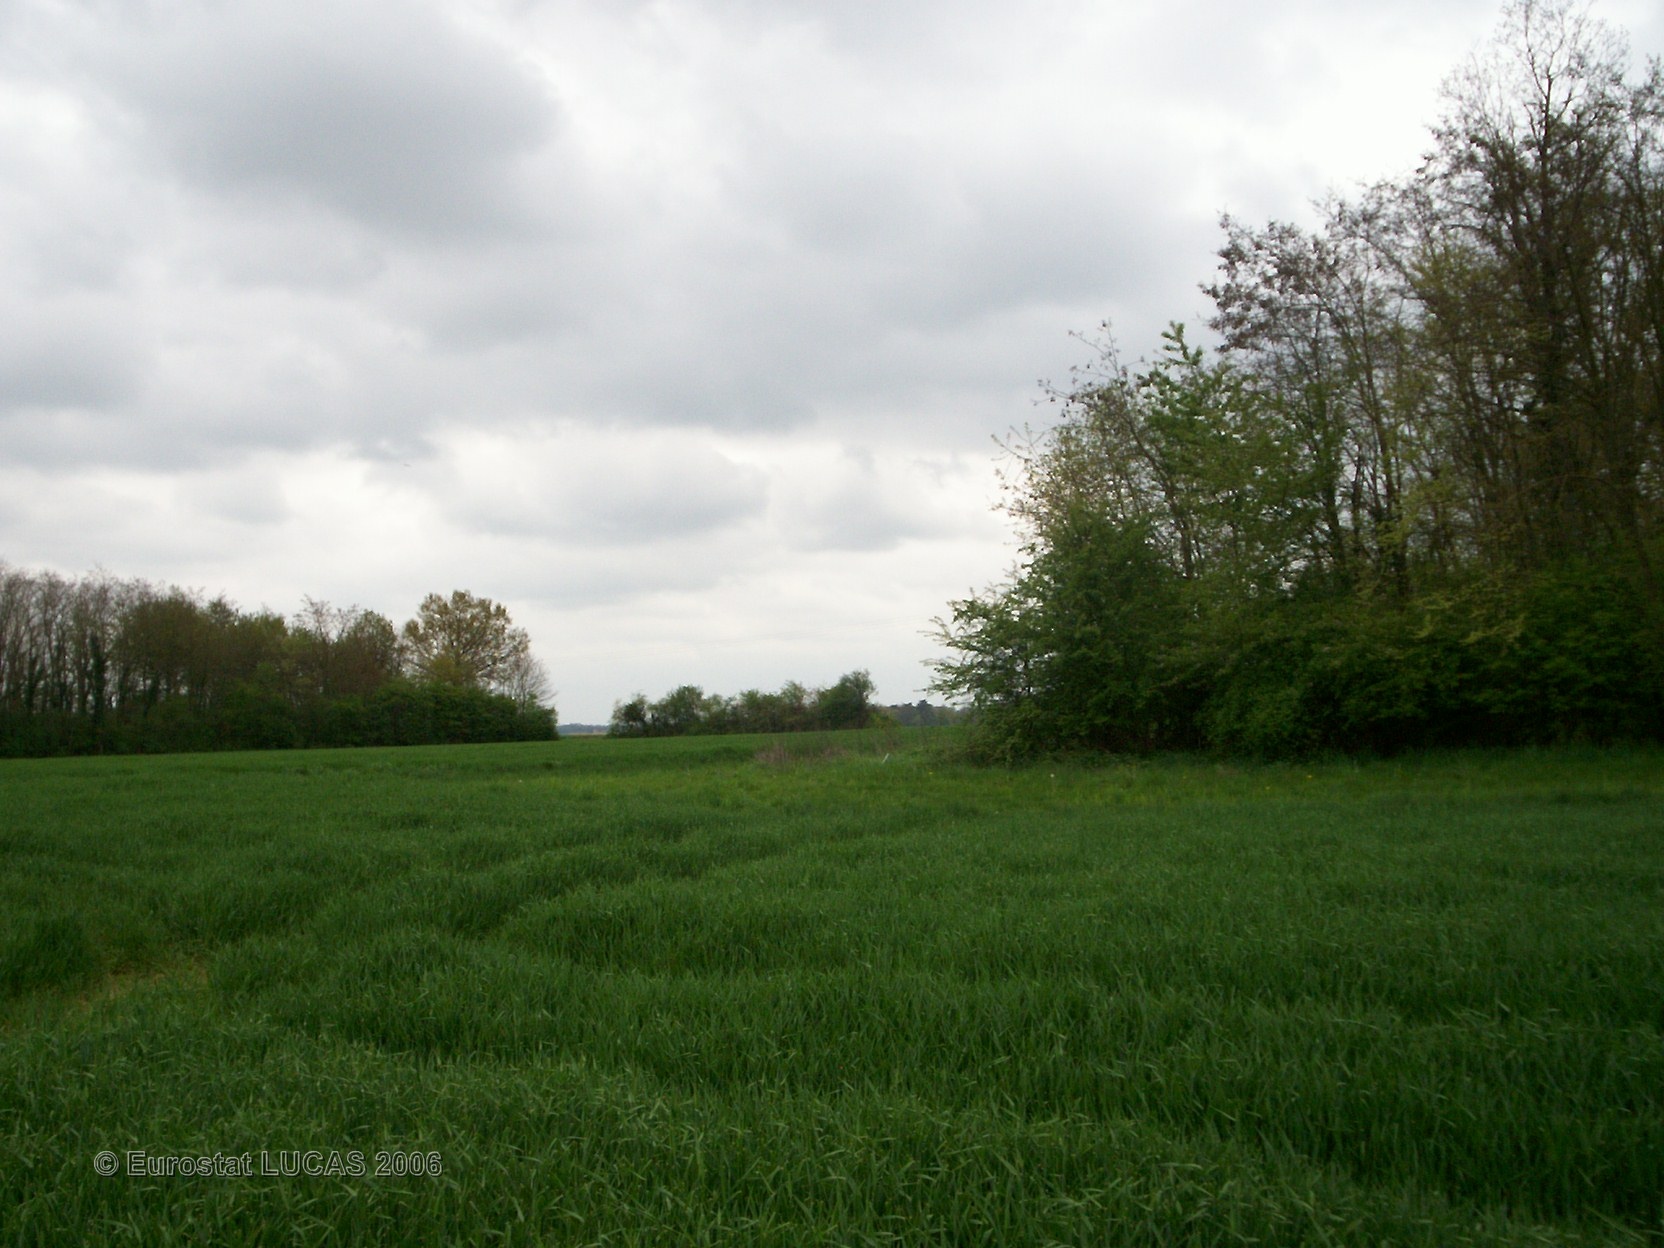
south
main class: Cropland
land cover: Barley
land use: Agriculture (excluding fallow land and kitchen gardens)
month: May
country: FR
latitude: 48.1755
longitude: 2.9049
